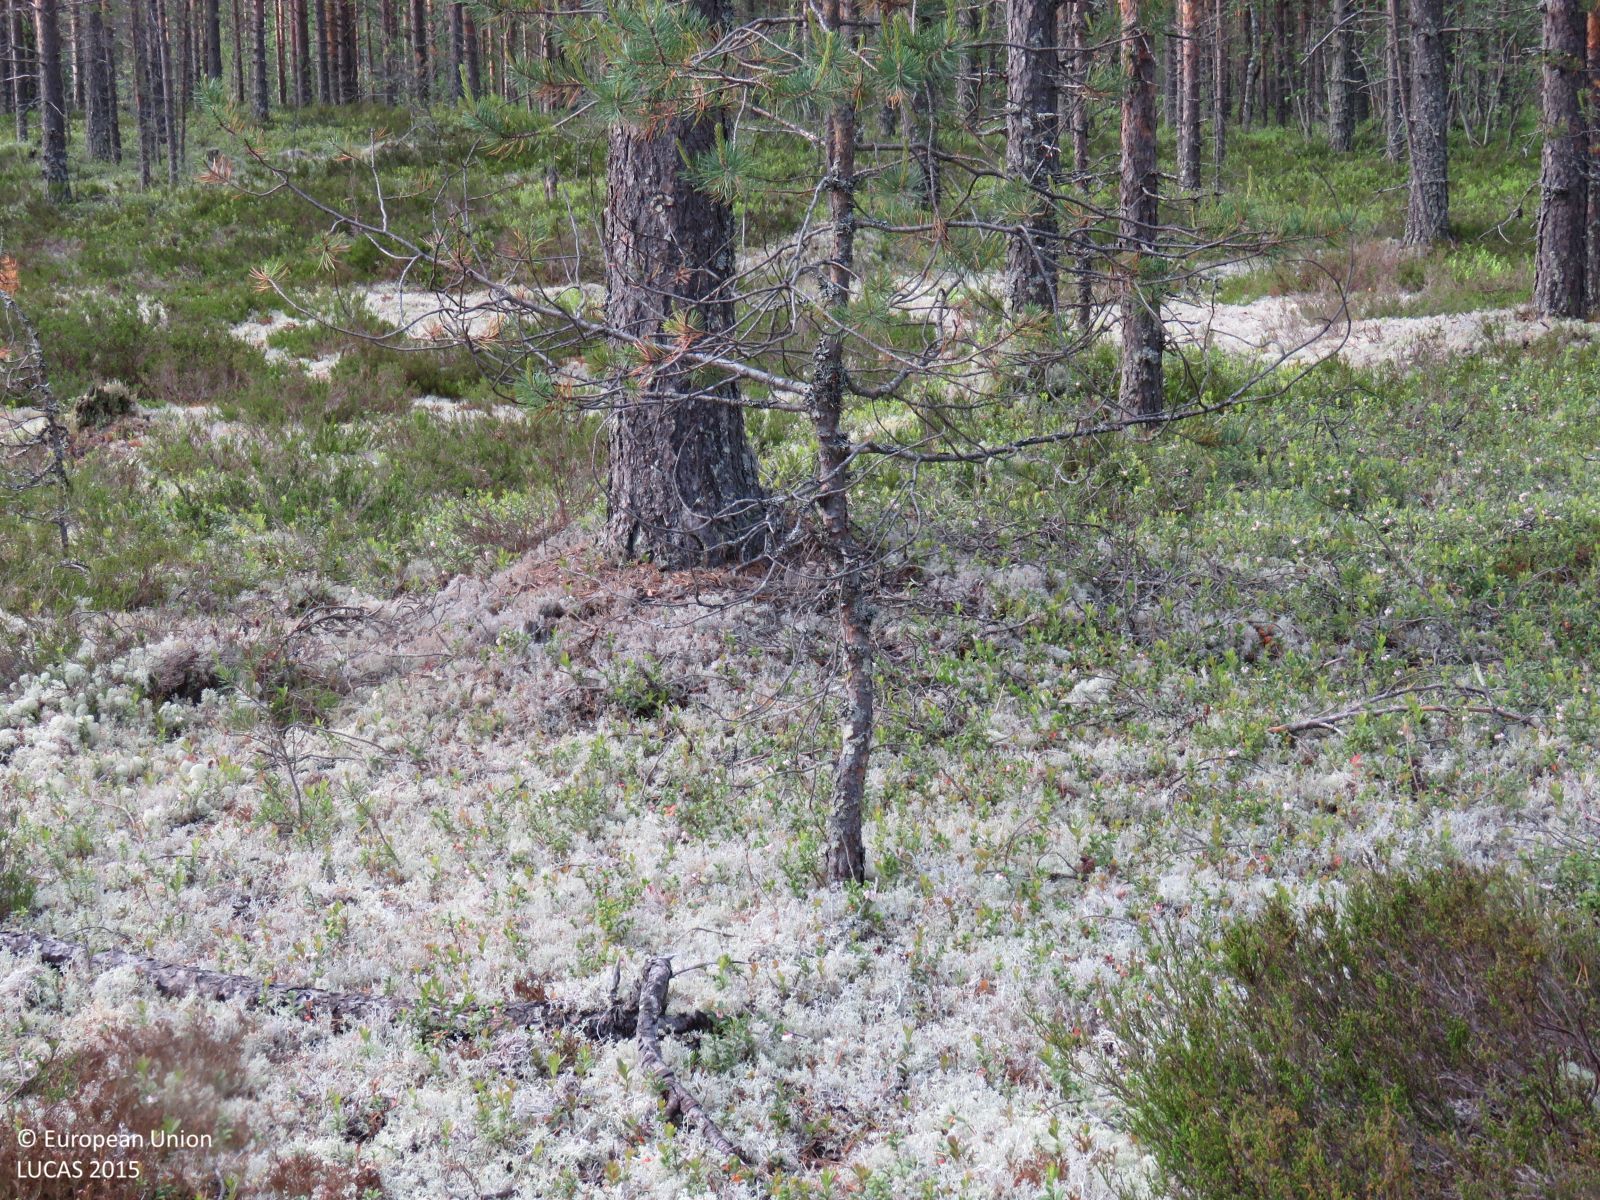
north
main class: Woodland
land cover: Pine dominated coniferous woodland
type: boreal forest
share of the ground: 25 - 50 %
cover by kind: coniferous forest trees 40 %, shrubs 40 %, lichens and mosses 20 %
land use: Forestry
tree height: > 5 m
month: June
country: FI
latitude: 64.0984
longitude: 26.5138
